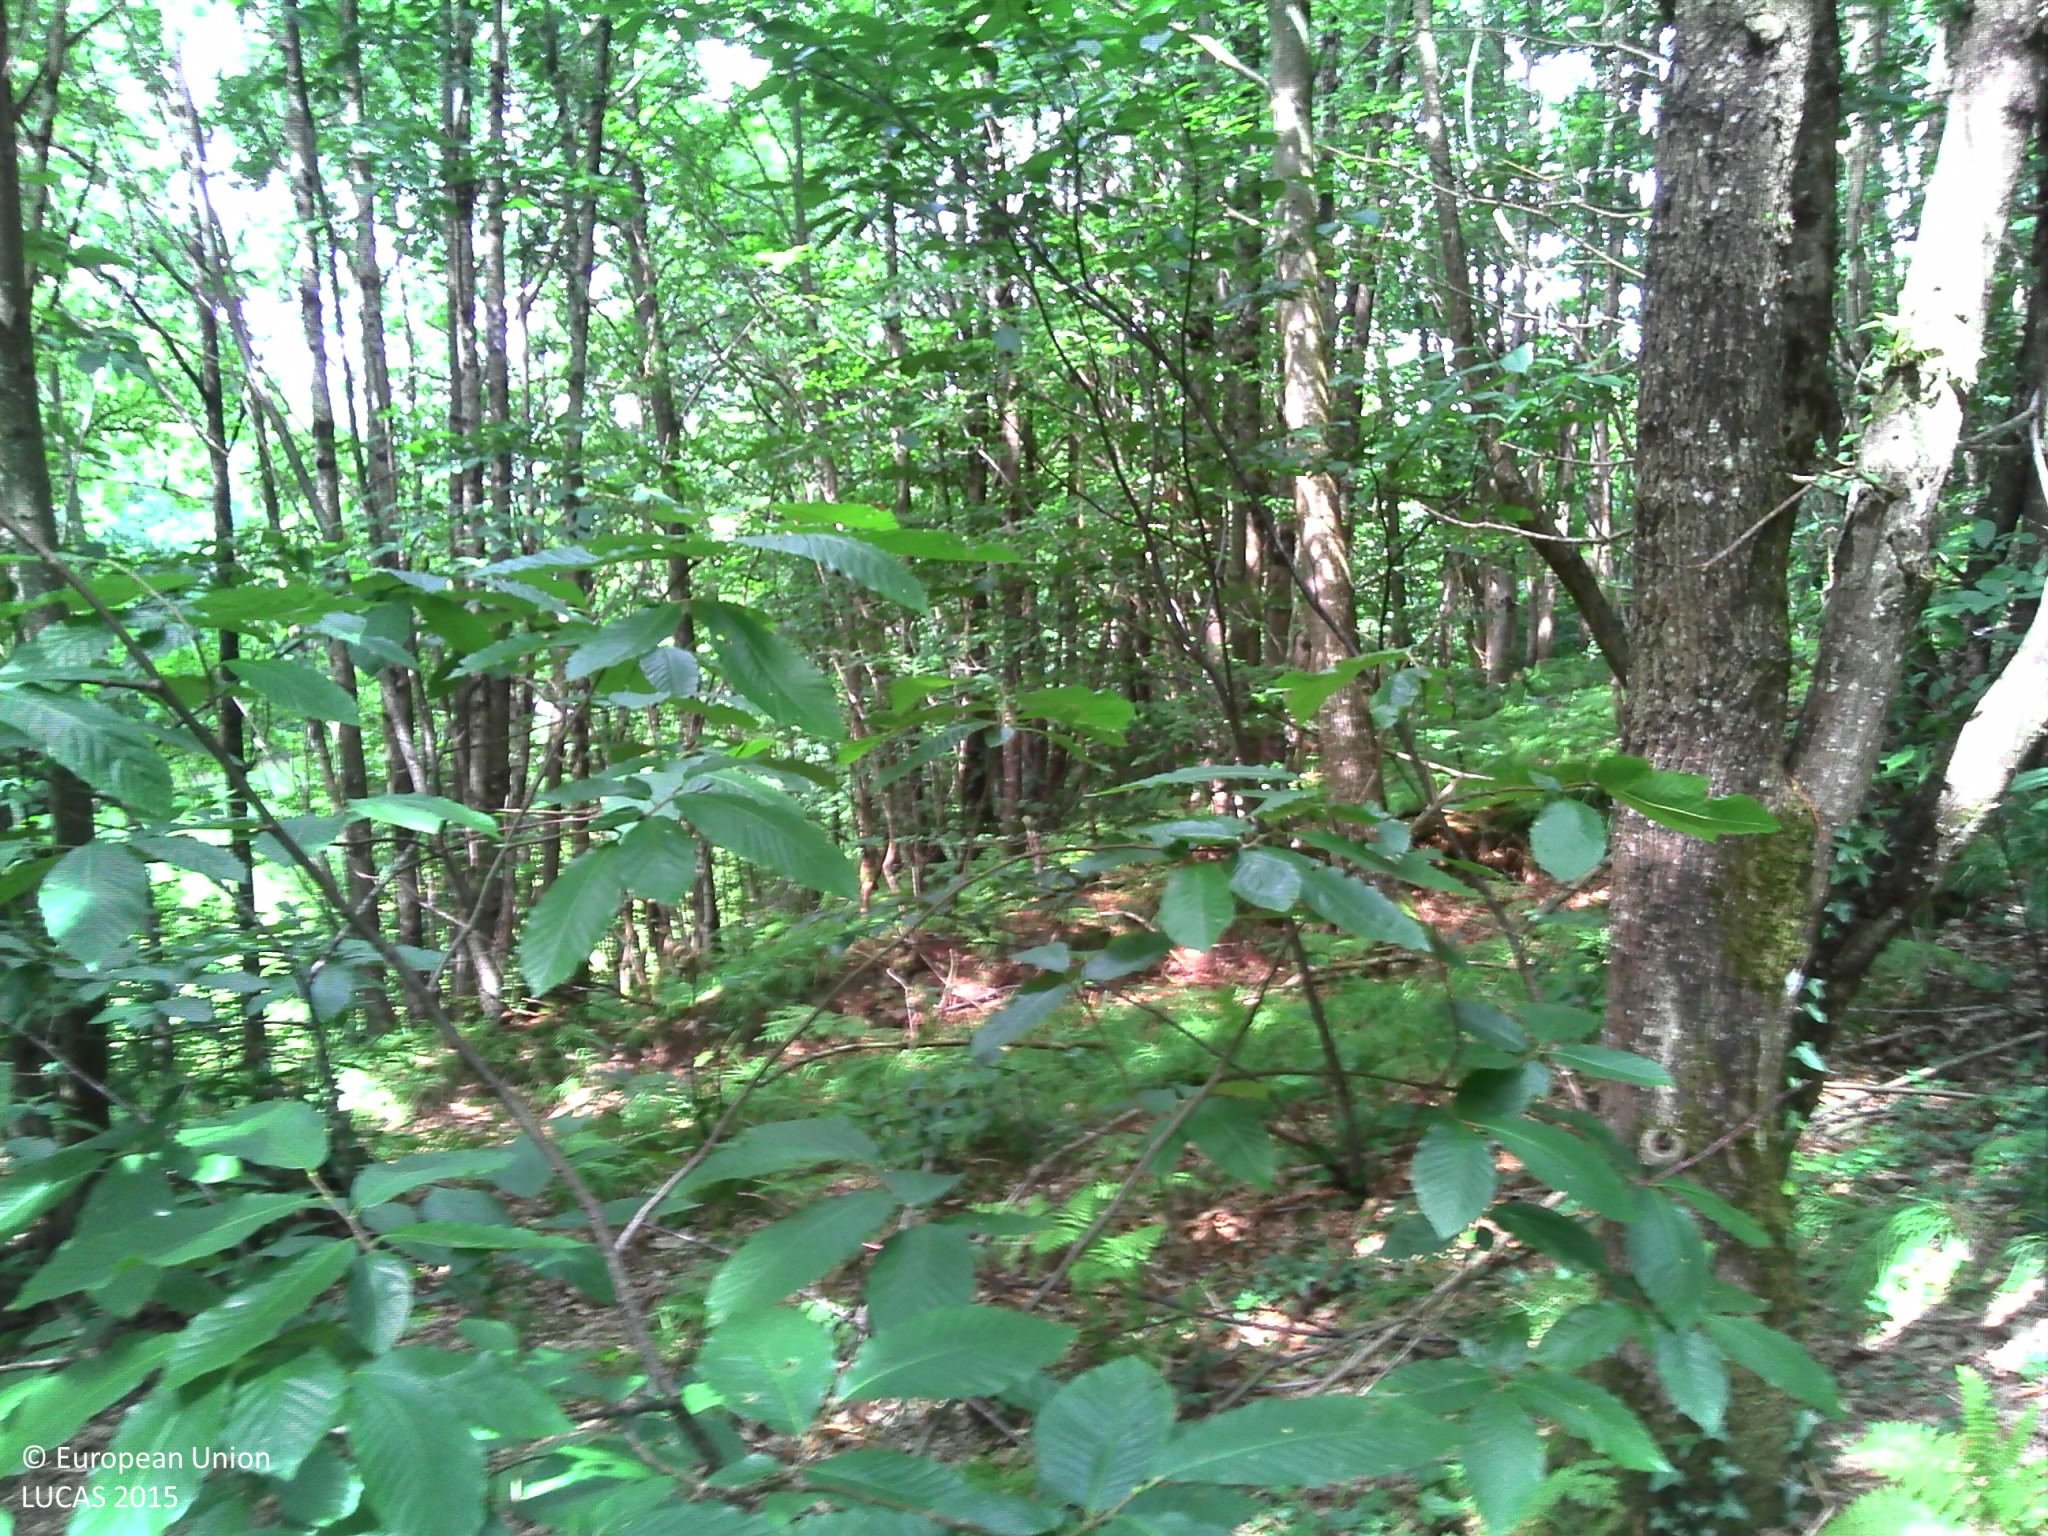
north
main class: Woodland
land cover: Broadleaved woodland
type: mesophytic deciduous forest
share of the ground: > 75 %
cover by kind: broadleaved forest trees 100 %
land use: Forestry
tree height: > 5 m
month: August
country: FR
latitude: 48.7016
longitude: -1.2268
